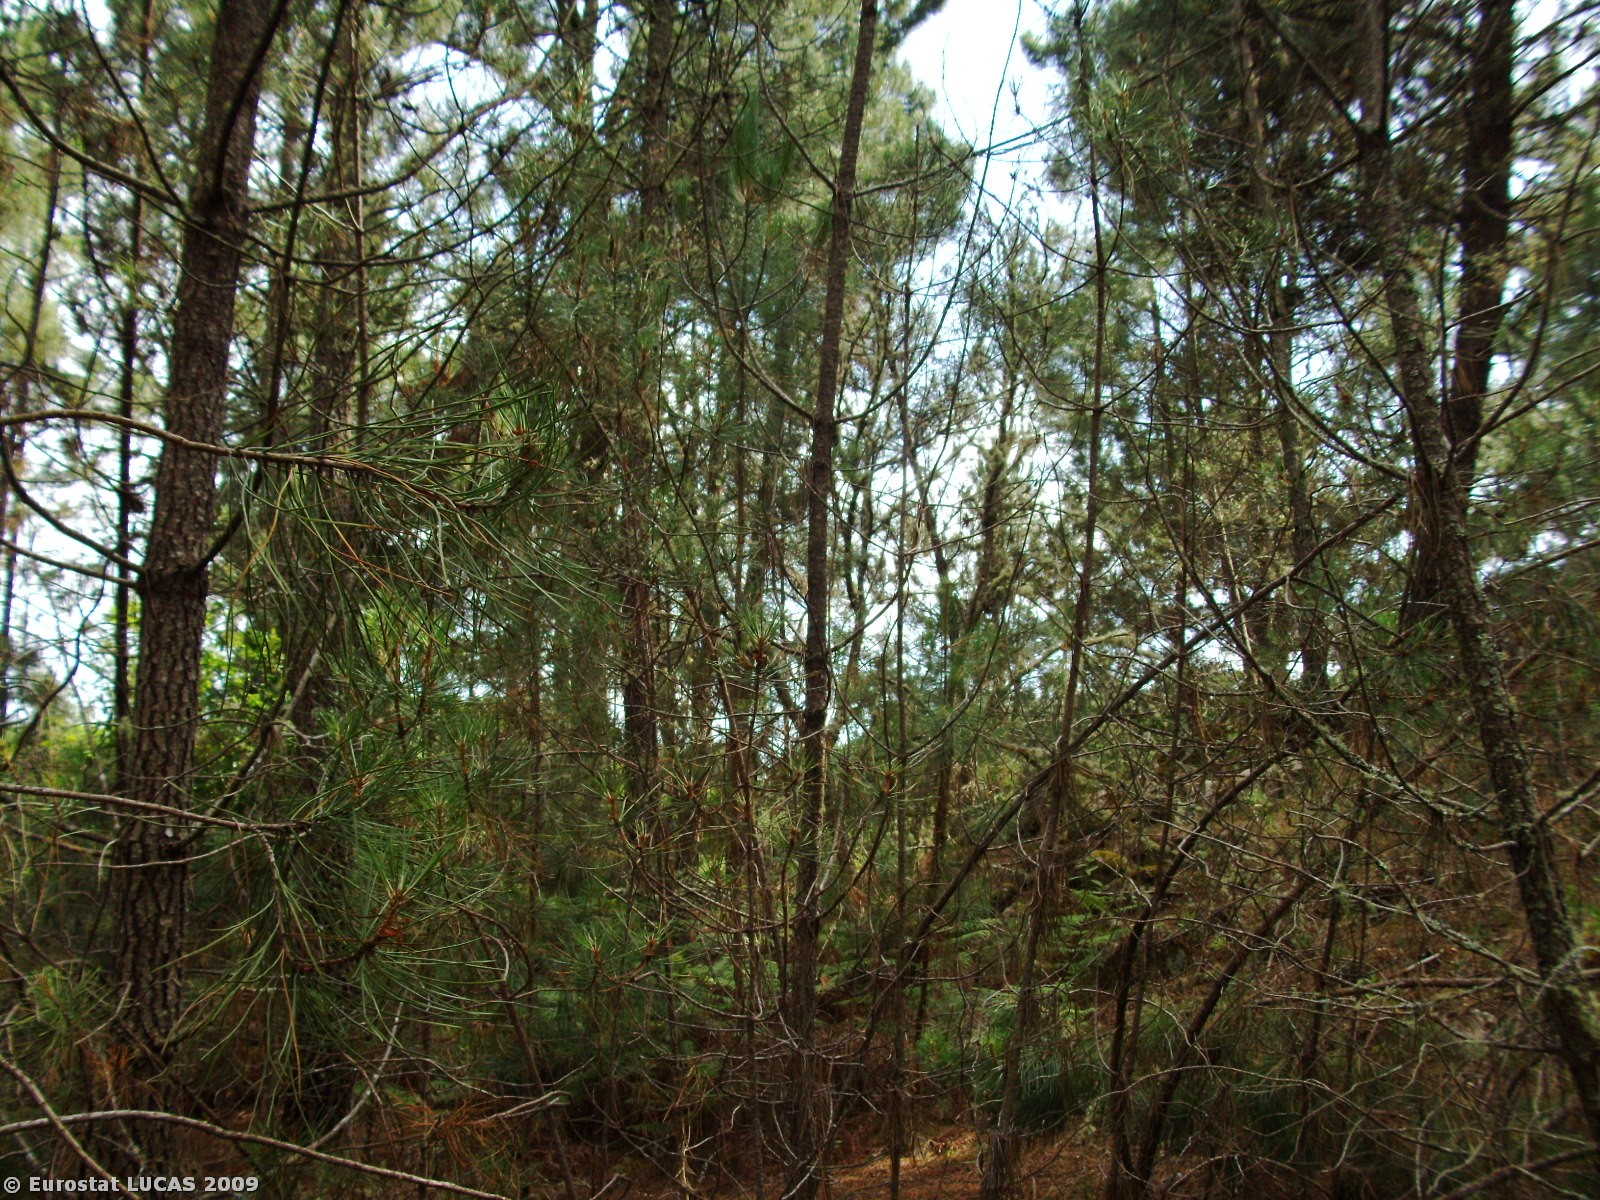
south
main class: Woodland
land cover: Coniferous woodland
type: coniferous forest of the mediterranean region
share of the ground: > 75 %
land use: Forestry
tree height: > 5 m
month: July
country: PT
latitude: 40.7294
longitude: -7.7027
